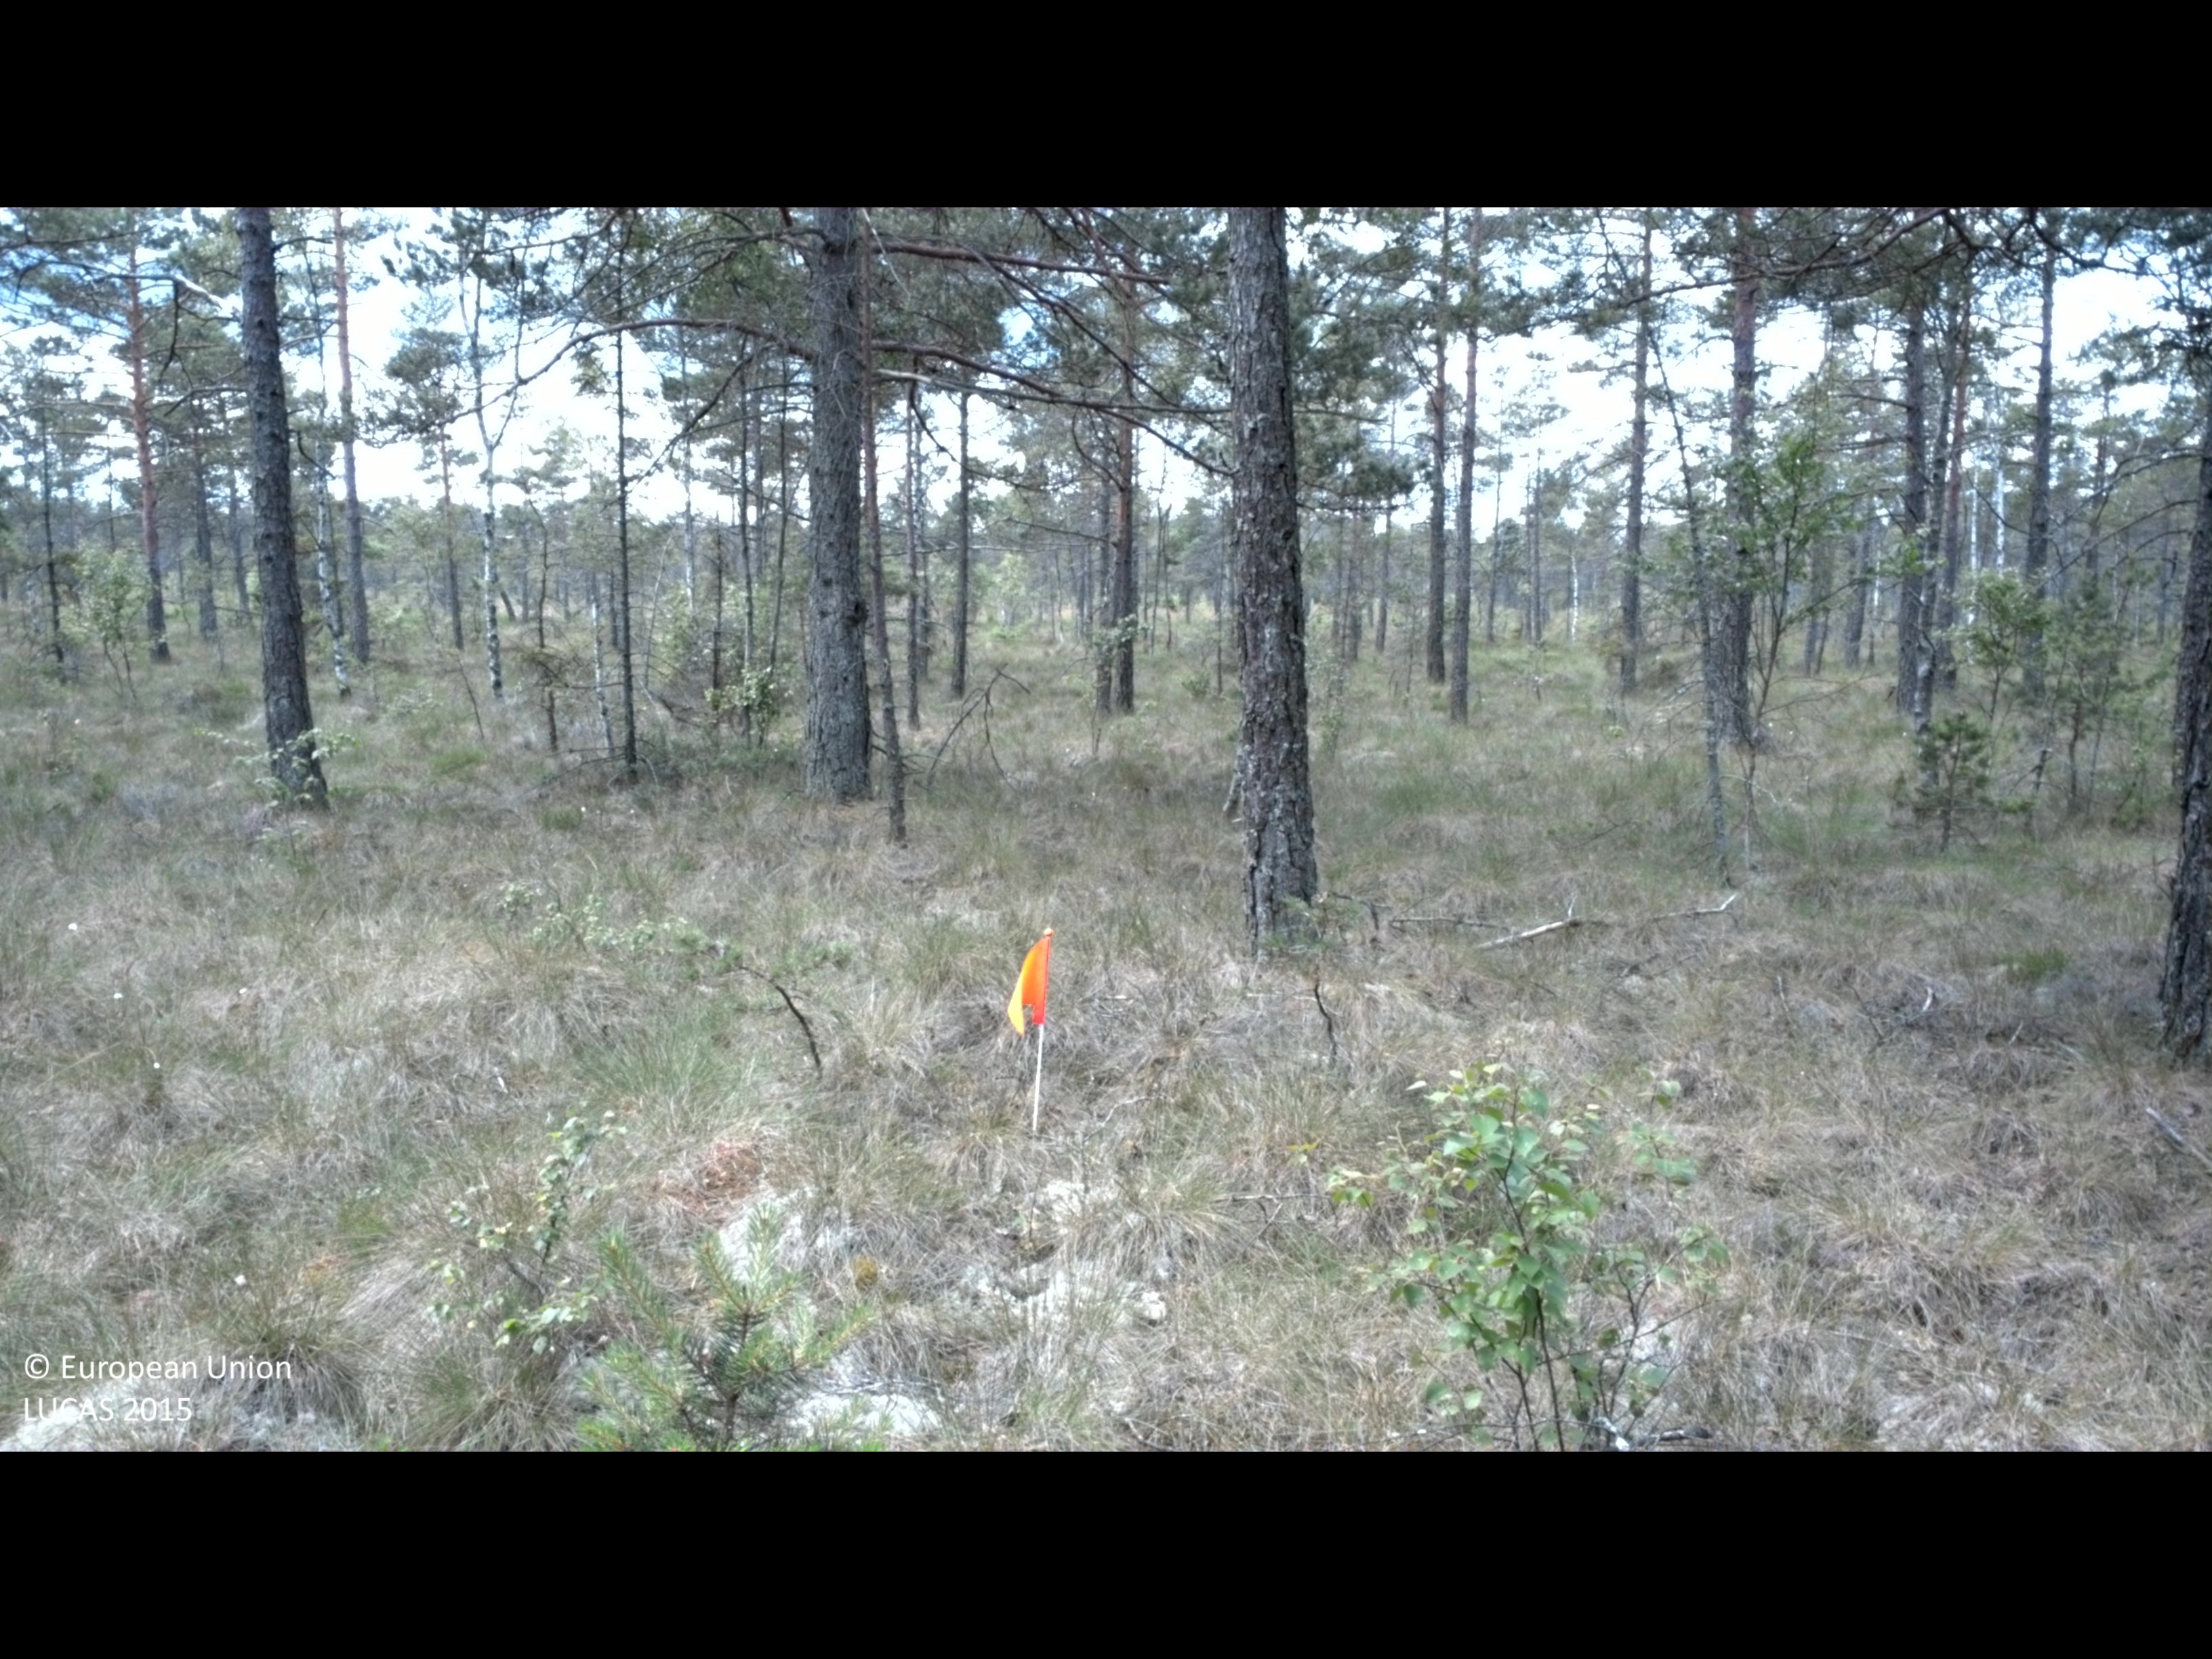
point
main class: Woodland
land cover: Pine dominated mixed woodland
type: mire and swamp forests
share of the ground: 50 - 75 %
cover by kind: coniferous forest trees 40 %, broadleaved forest trees 20 %, herbaceous plants 20 %, shrubs 10 %, lichens and mosses 10 %
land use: Semi-natural and natural areas not in use
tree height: > 5 m
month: July
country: SE
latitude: 56.5667
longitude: 14.2772
